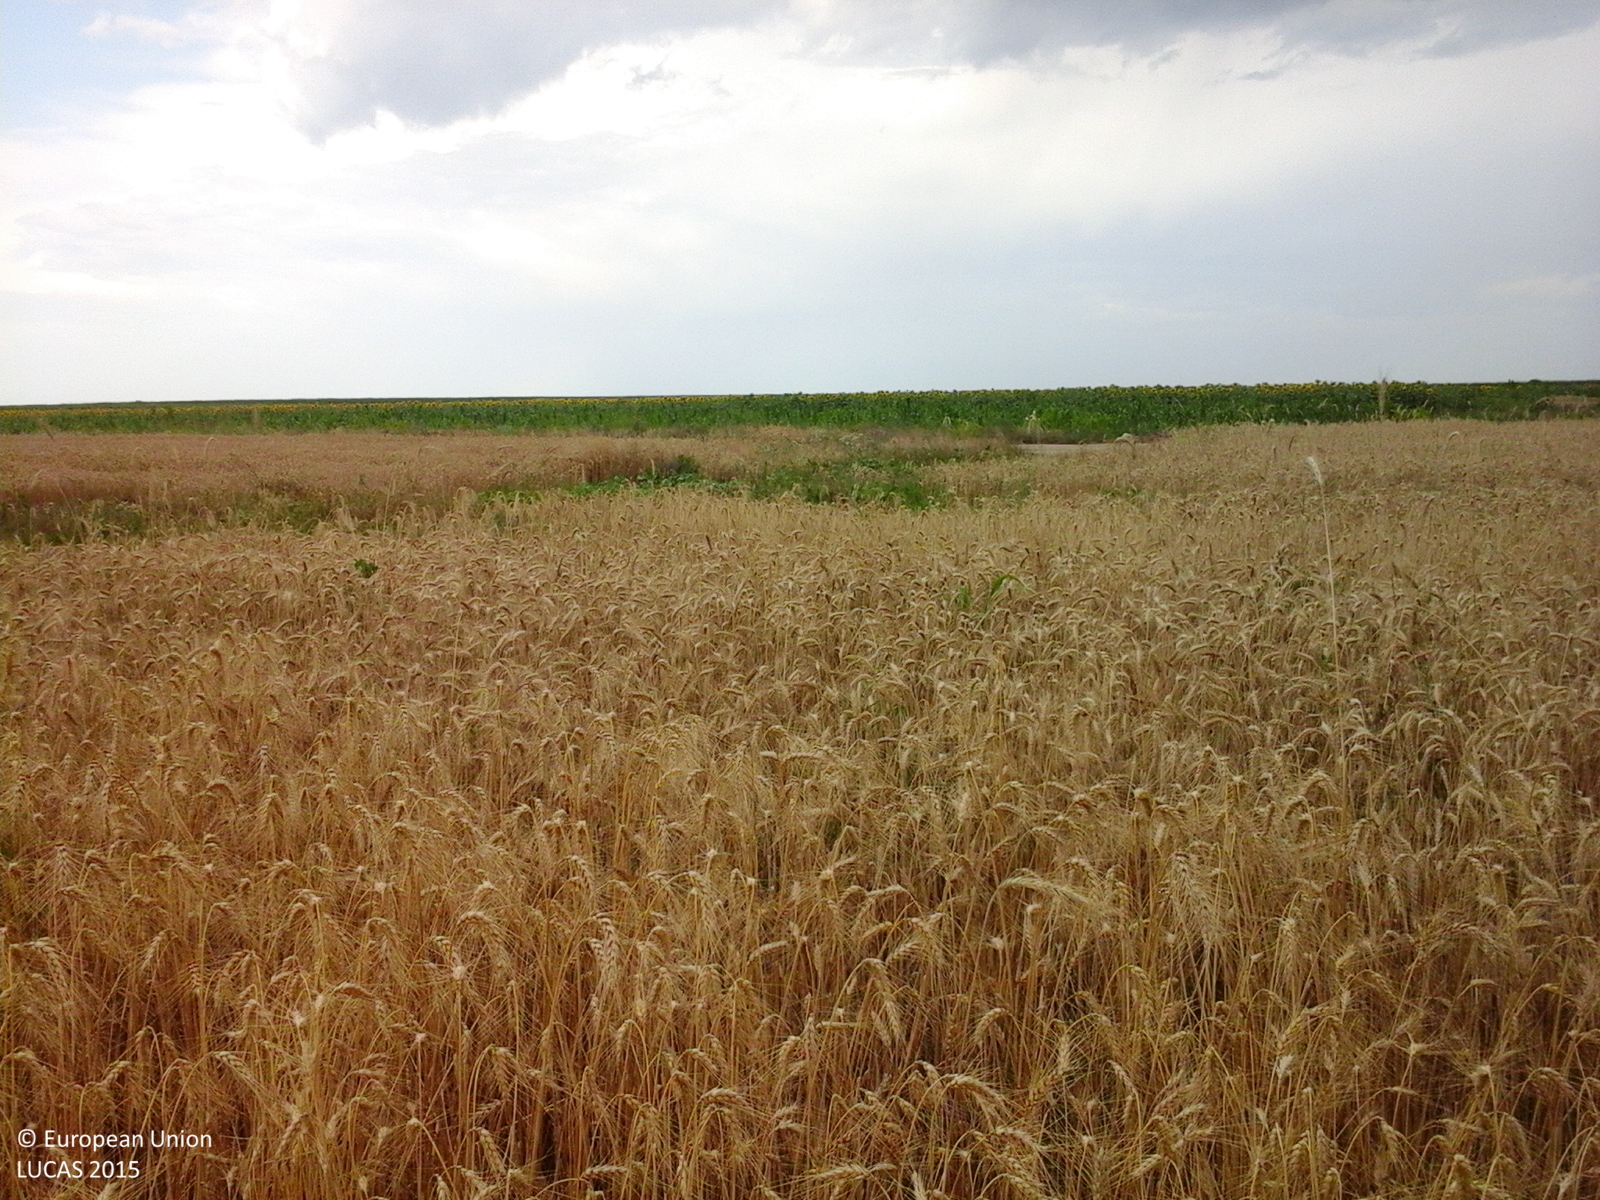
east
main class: Cropland
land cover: Common wheat
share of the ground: > 75 %
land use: Agriculture (excluding fallow land and kitchen gardens)
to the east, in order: Common wheat; Grass margins; Tracks; Grass margins; Maize; Sunflower; Grassland without tree/shrub cover; Maize; Sunflower; Grassland without tree/shrub cover; Sunflower; Maize
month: July
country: RO
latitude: 43.9557
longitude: 24.0523
